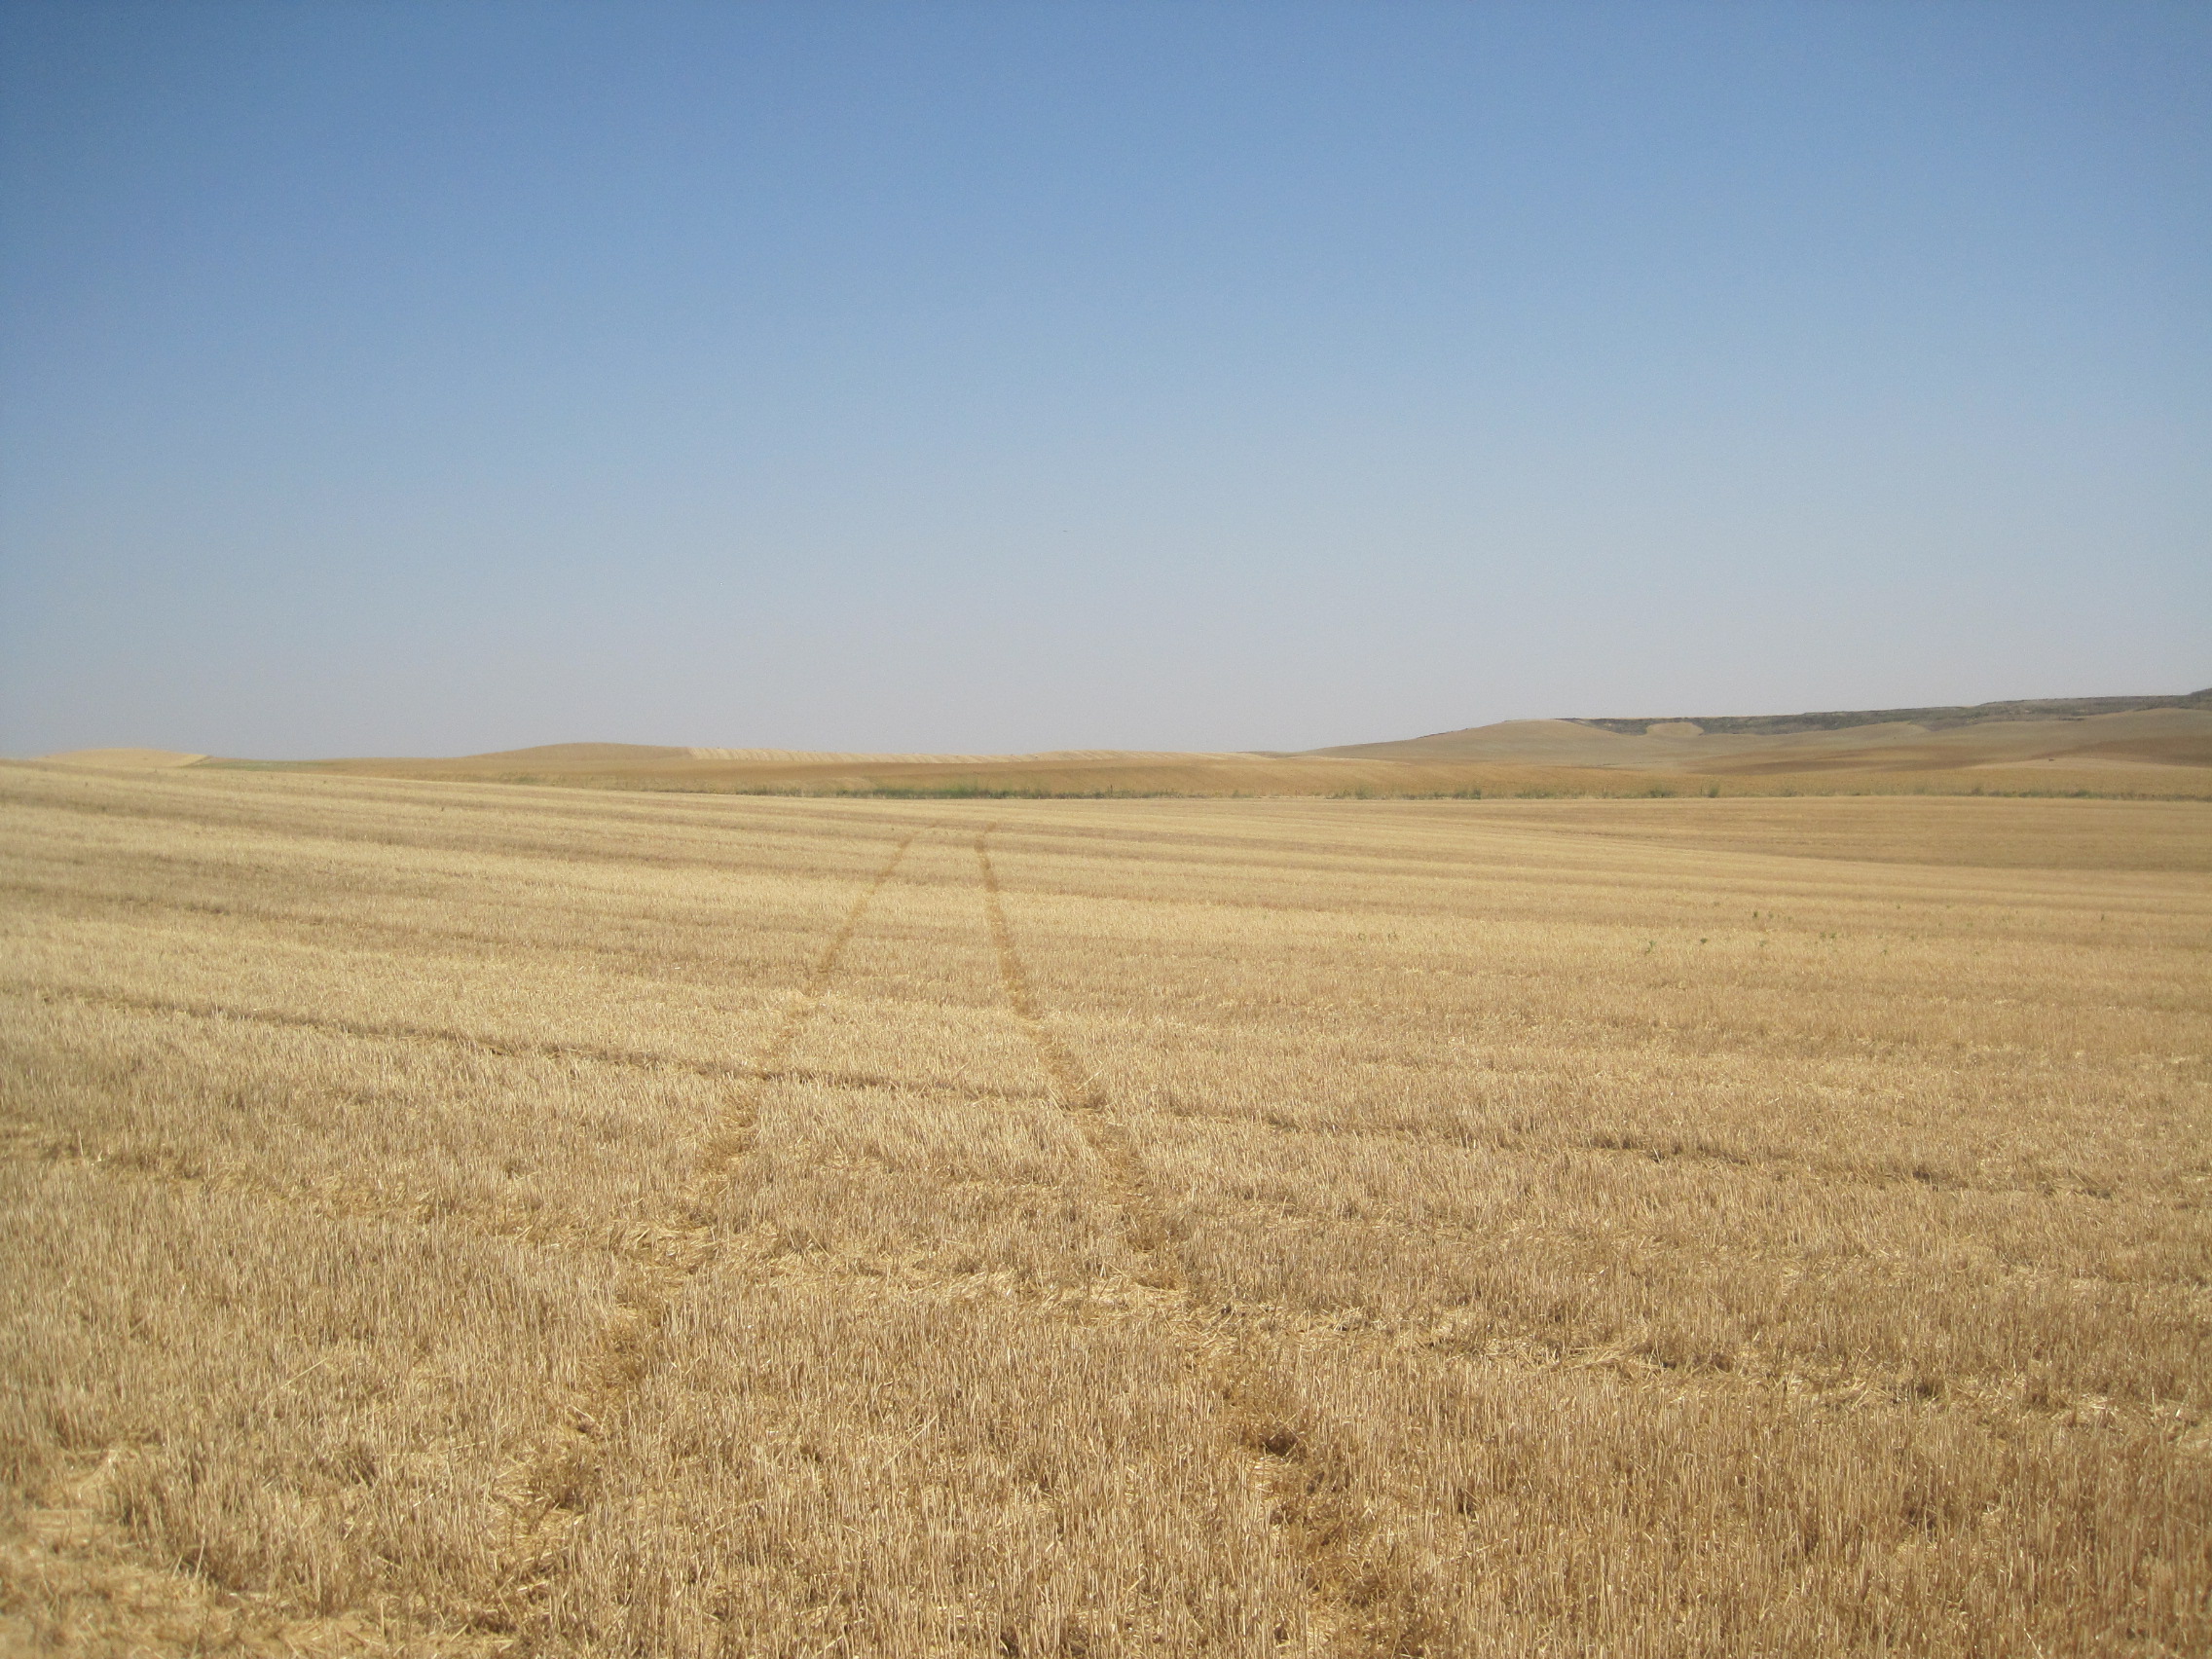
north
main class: Cropland
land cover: Barley
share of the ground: < 10 %
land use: Agriculture (excluding fallow land and kitchen gardens)
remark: Harvested field
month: July
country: ES
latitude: 41.6280
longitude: -5.4339
